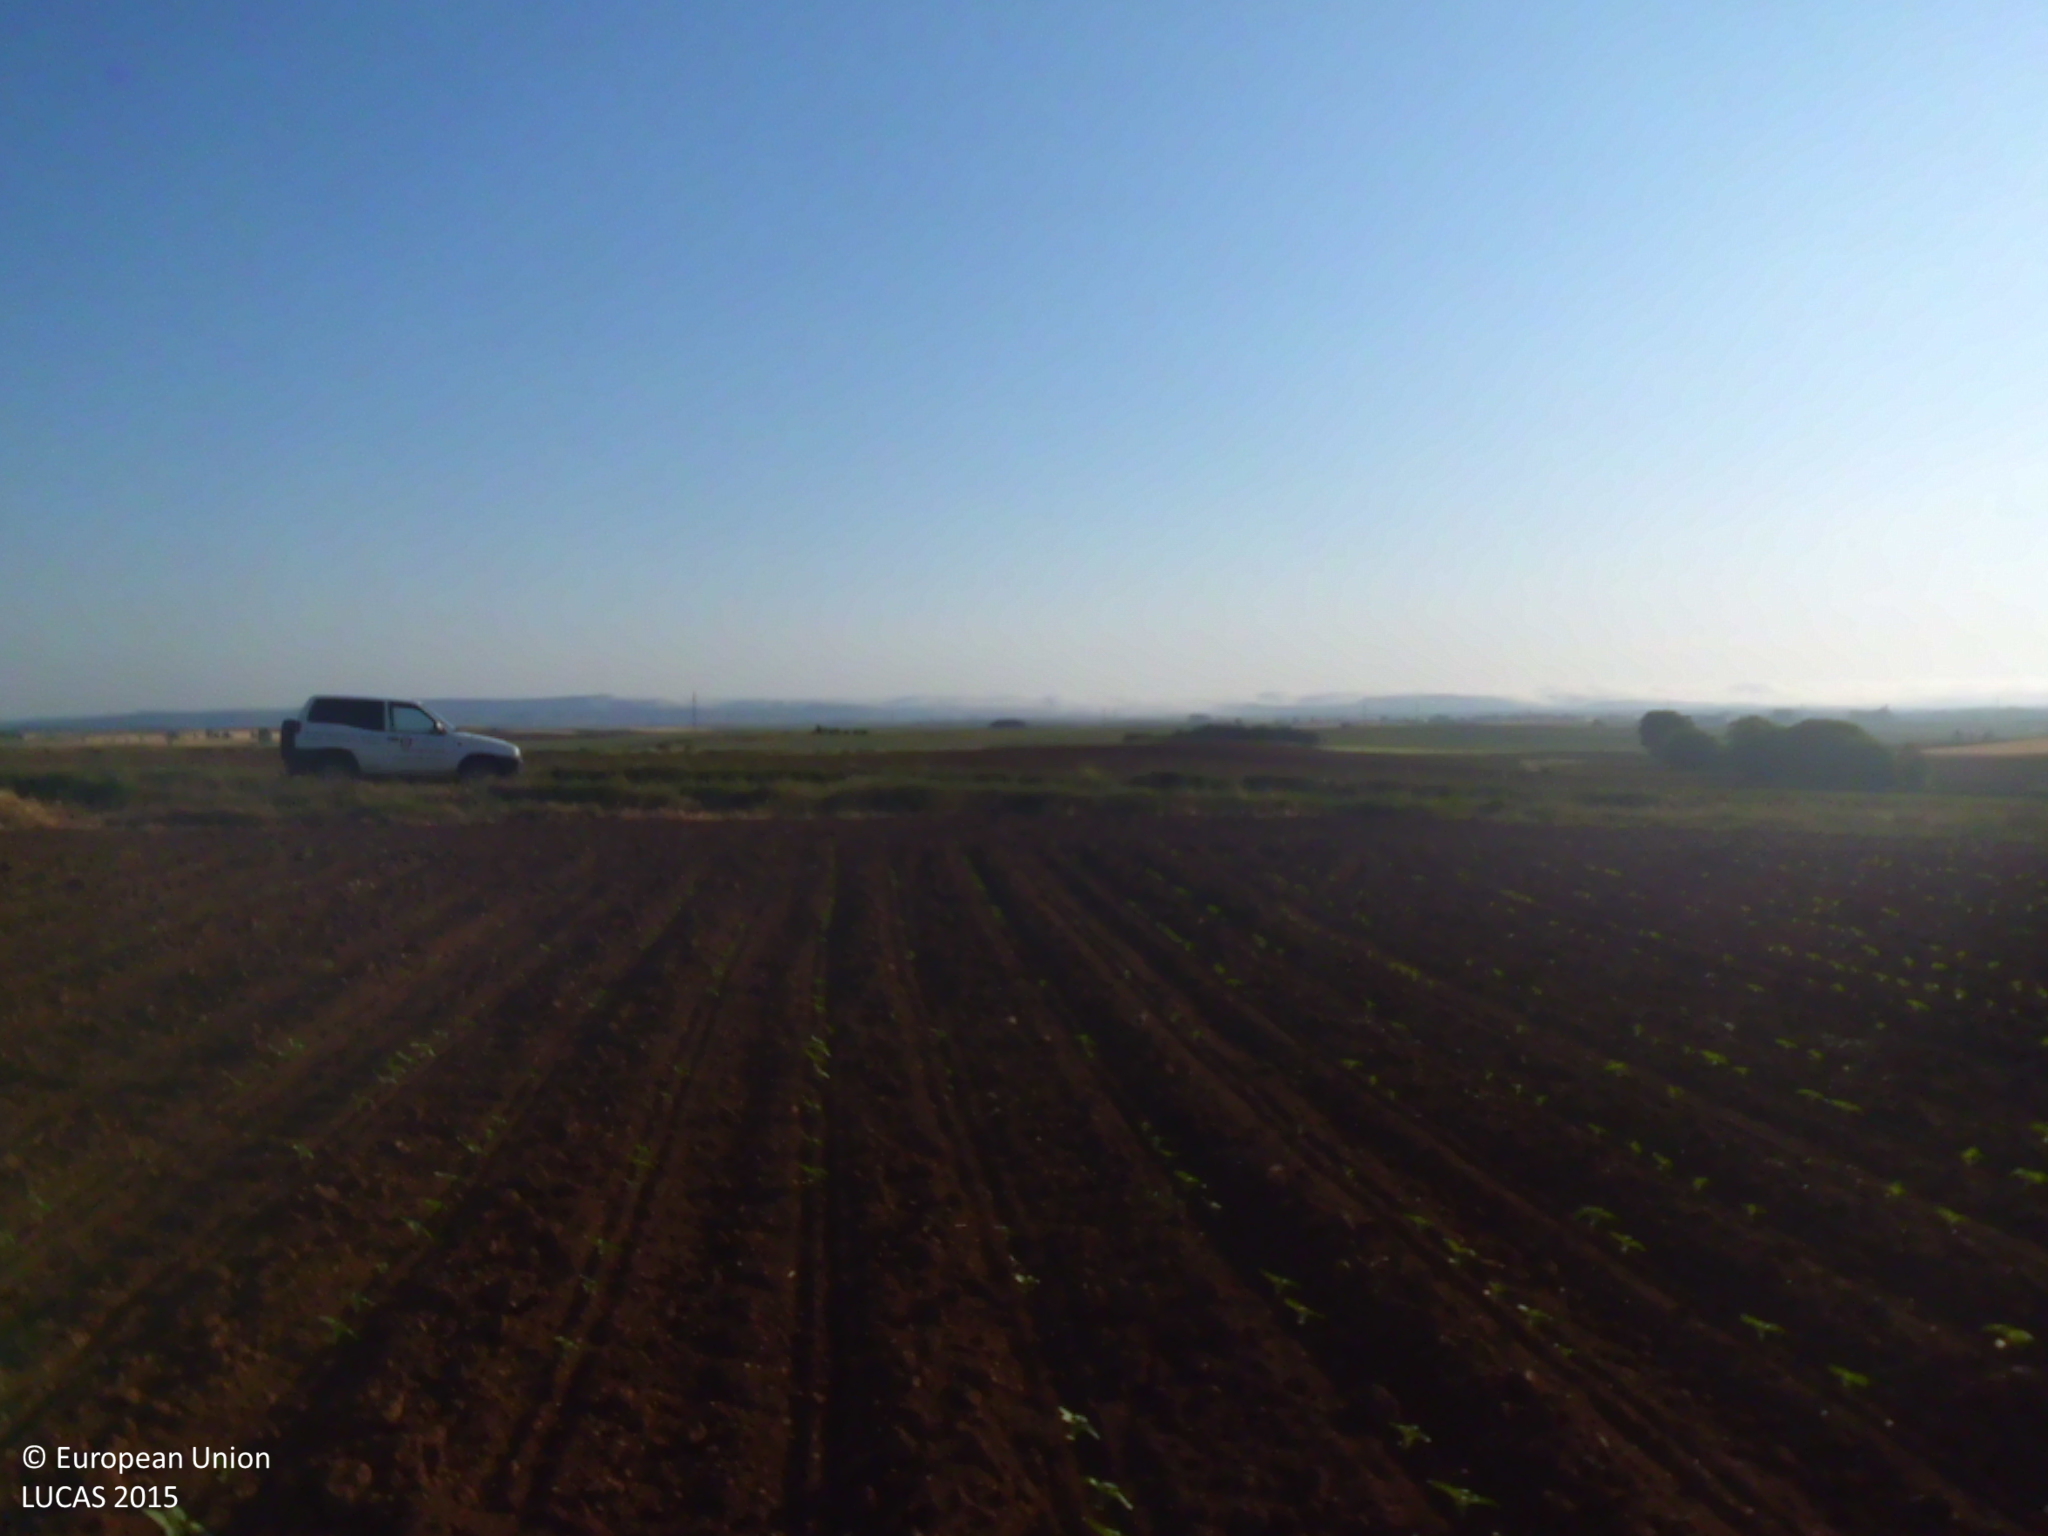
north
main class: Cropland
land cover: Sunflower
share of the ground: < 10 %
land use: Agriculture (excluding fallow land and kitchen gardens)
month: June
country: ES
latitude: 42.4931
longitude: -4.0478
